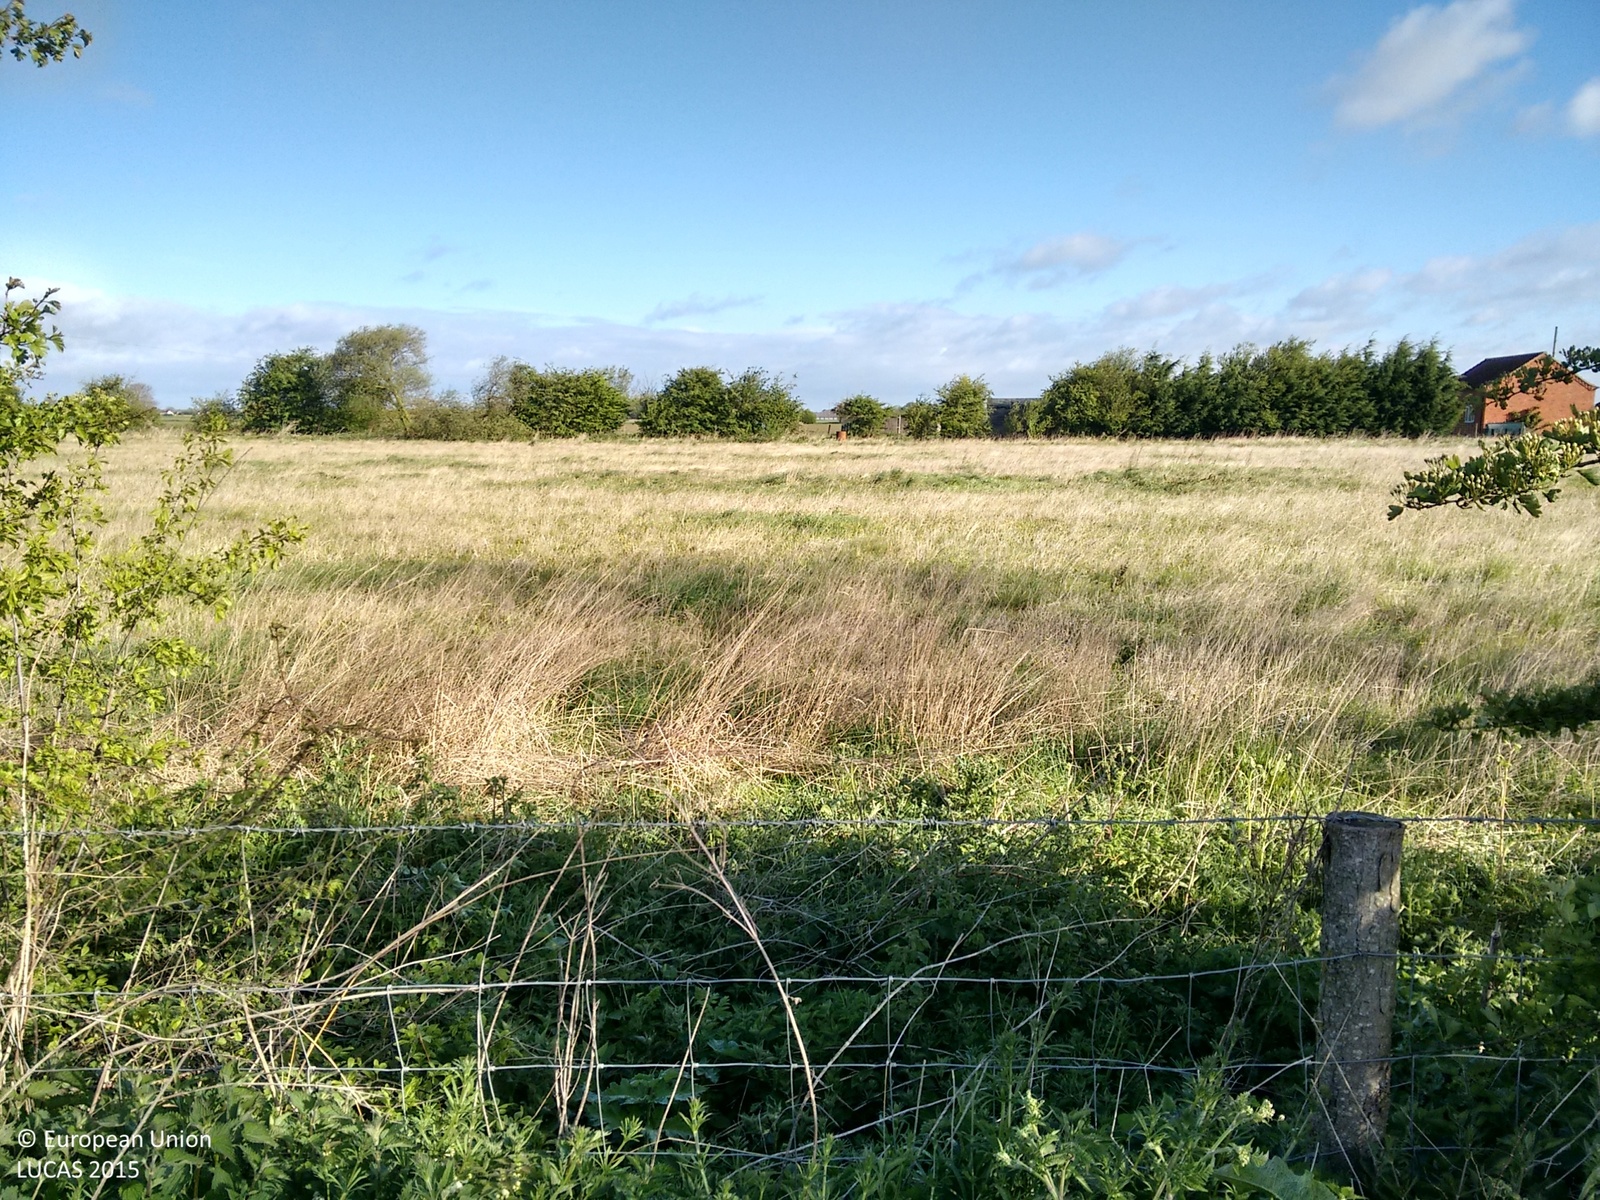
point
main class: Grassland
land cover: Grassland without tree/shrub cover
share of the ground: > 75 %
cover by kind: herbaceous plants 100 %
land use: Agriculture (excluding fallow land and kitchen gardens)
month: May
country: GB
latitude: 53.0661
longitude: -0.1367
